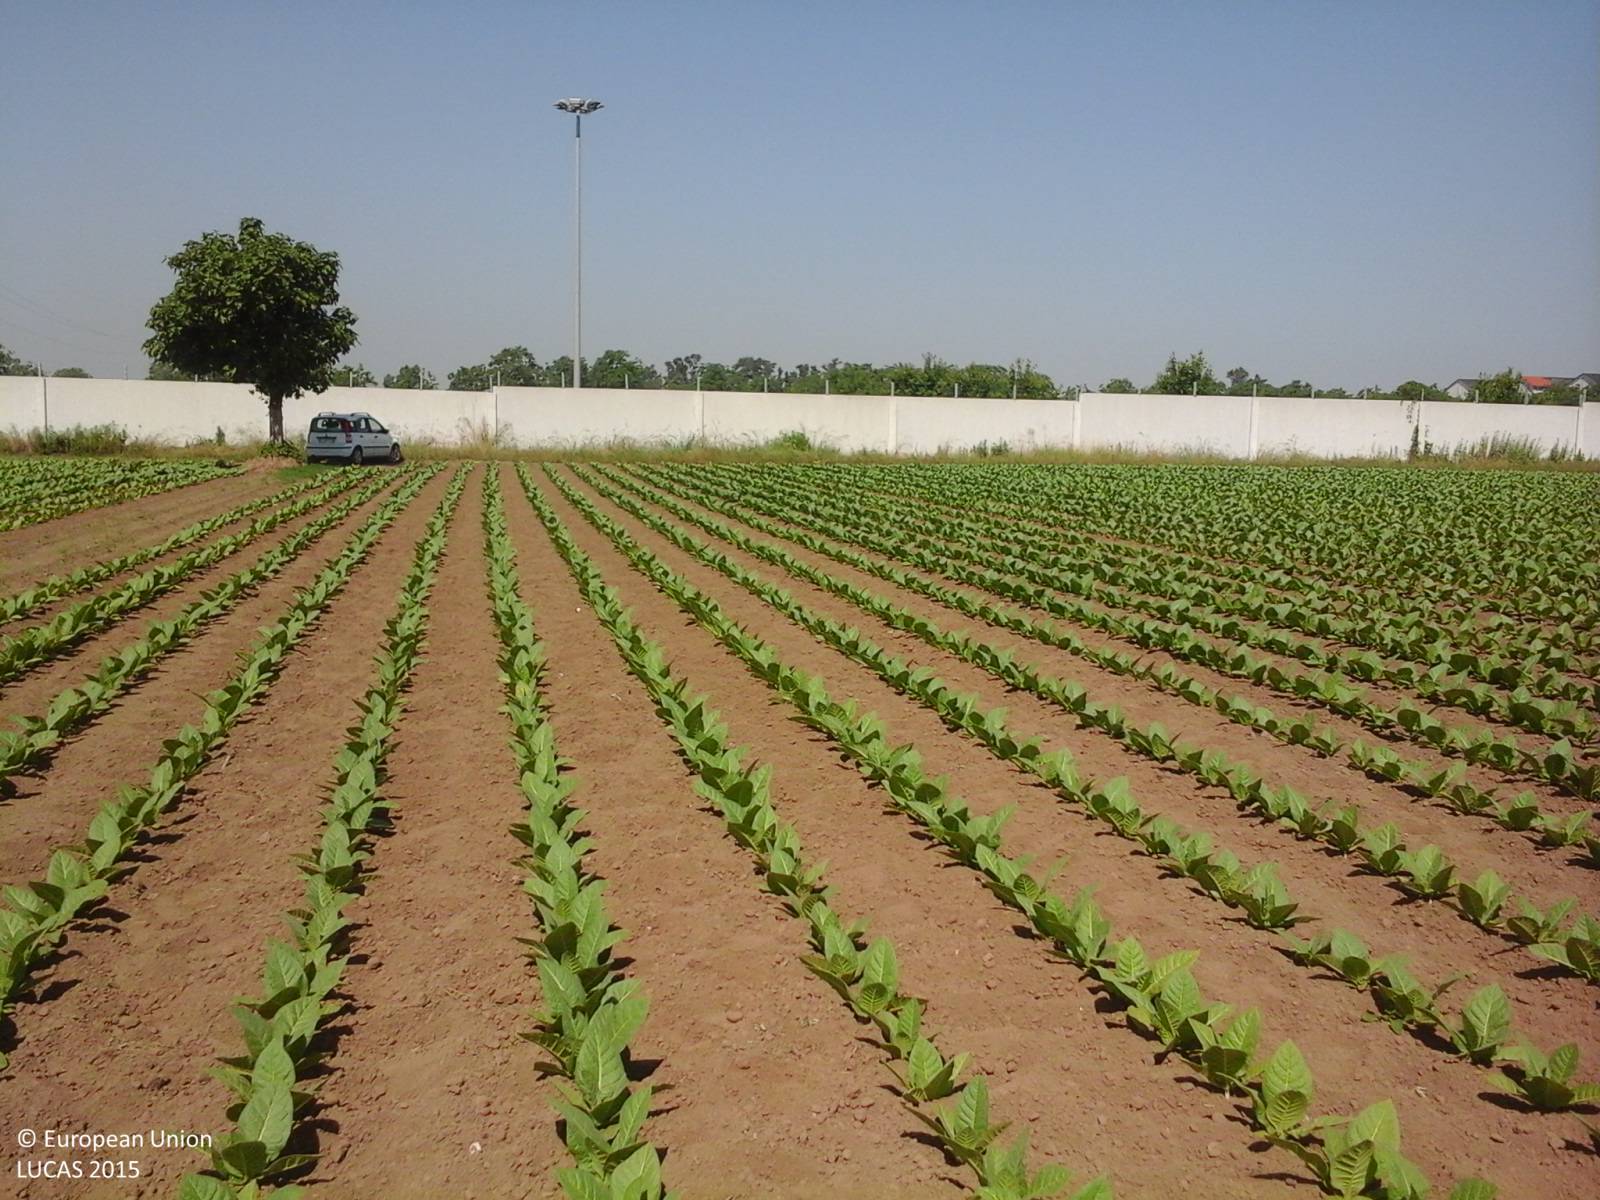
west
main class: Cropland
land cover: Tobacco
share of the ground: 25 - 50 %
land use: Agriculture (excluding fallow land and kitchen gardens)
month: June
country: IT
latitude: 41.0225
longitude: 14.3471
